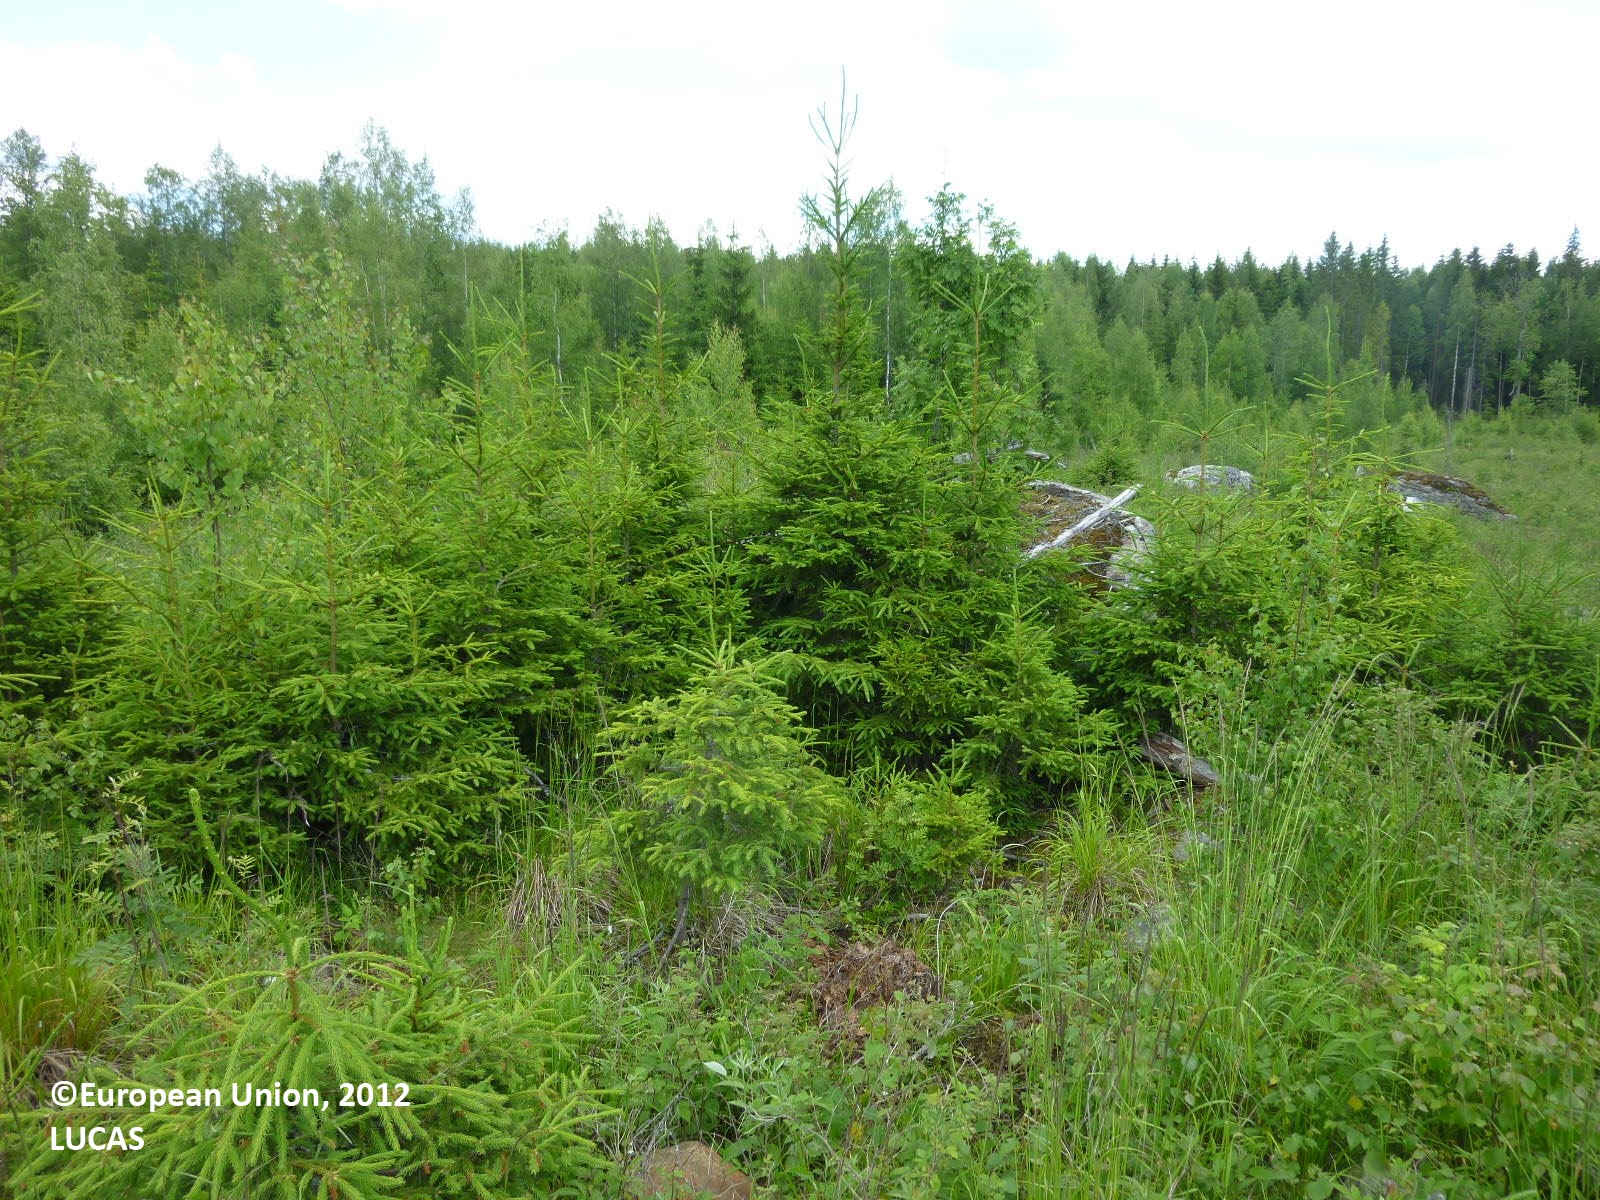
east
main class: Woodland
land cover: Spruce dominated mixed woodland
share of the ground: 50 - 75 %
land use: Forestry
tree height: < 5 m
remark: Clear cut
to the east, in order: Spruce dominated mixed woodland; Broadleaved woodland; Ditches and canals; Broadleaved woodland; Ditches and canals; Broadleaved woodland; Ditches and canals; Broadleaved woodland; Spruce dominated mixed woodland
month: July
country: FI
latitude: 61.3794
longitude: 22.2437
